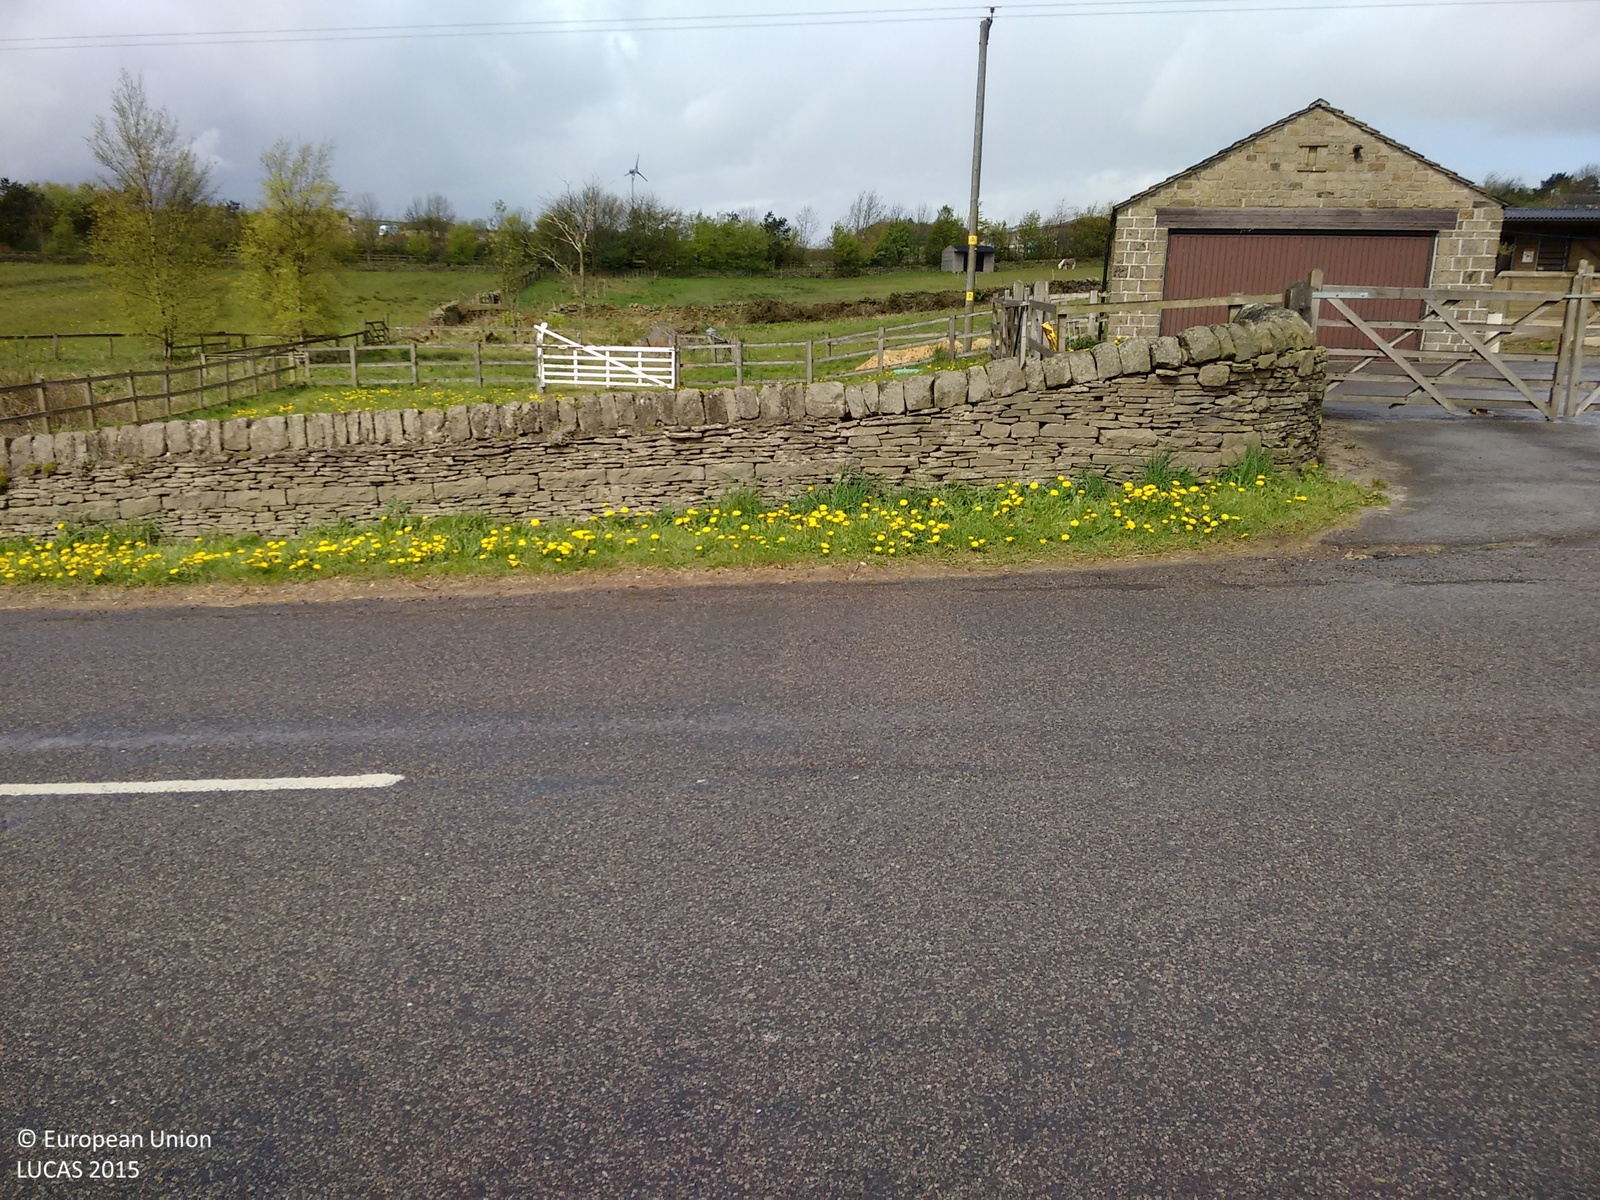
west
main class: Grassland
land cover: Grassland without tree/shrub cover
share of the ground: > 75 %
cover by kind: herbaceous plants 100 %
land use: Agriculture (excluding fallow land and kitchen gardens)
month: May
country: GB
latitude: 53.5573
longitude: -1.7223
